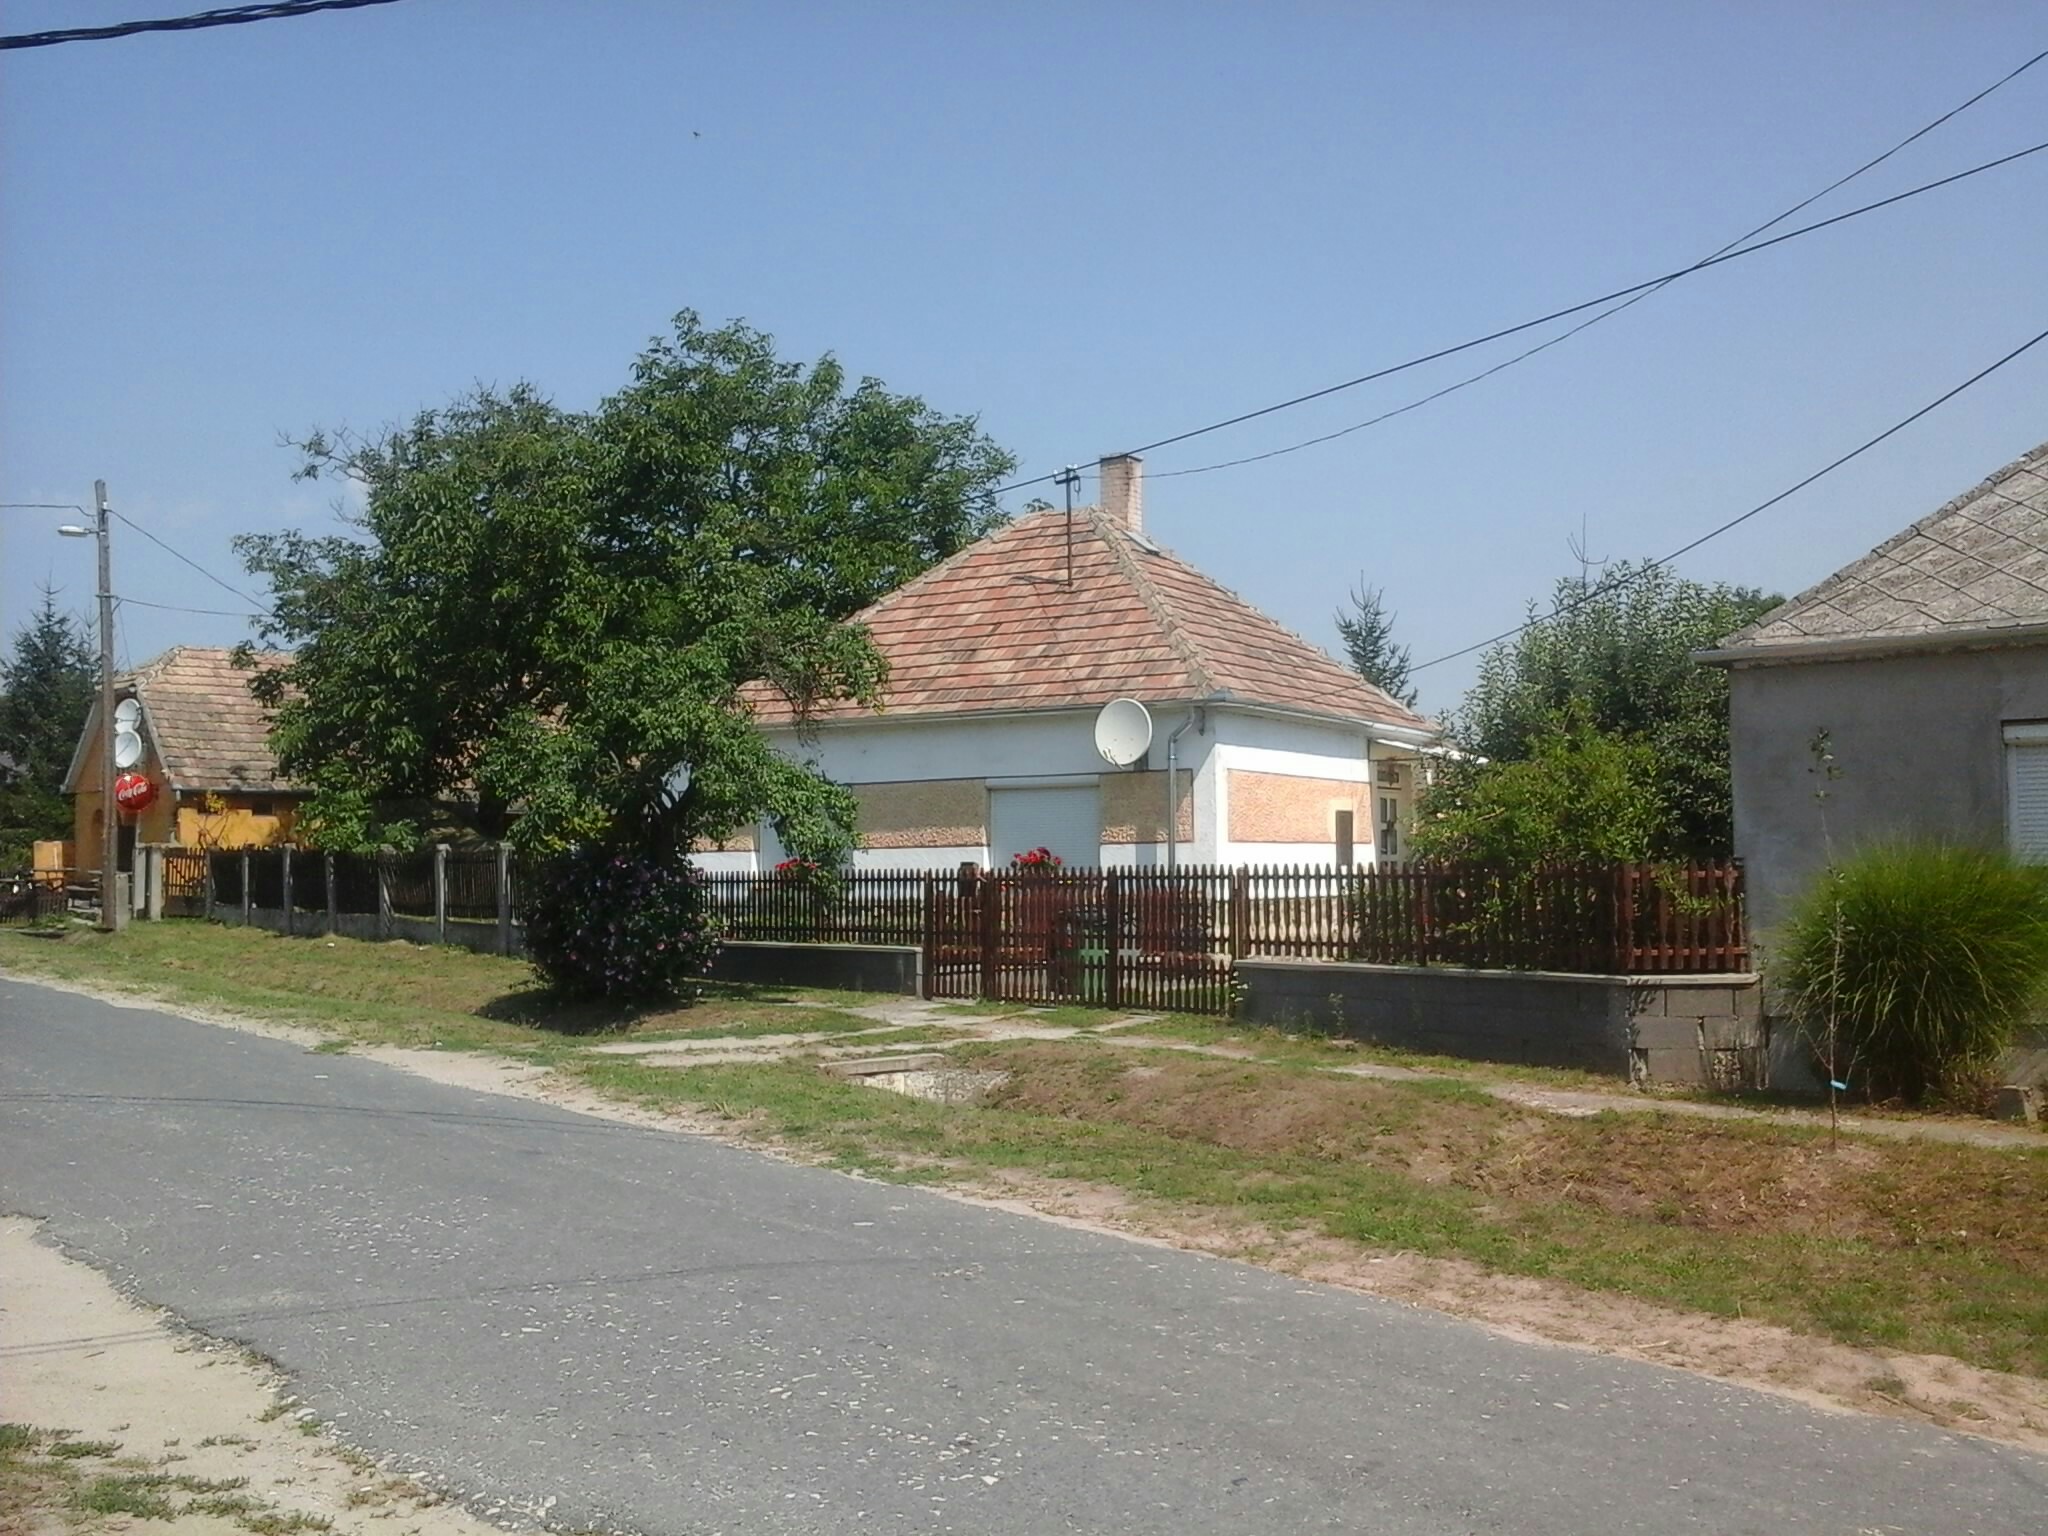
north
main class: Grassland
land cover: Grassland without tree/shrub cover
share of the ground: > 75 %
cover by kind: herbaceous plants 100 %
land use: Residential
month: August
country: HU
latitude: 47.4616
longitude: 18.0098
